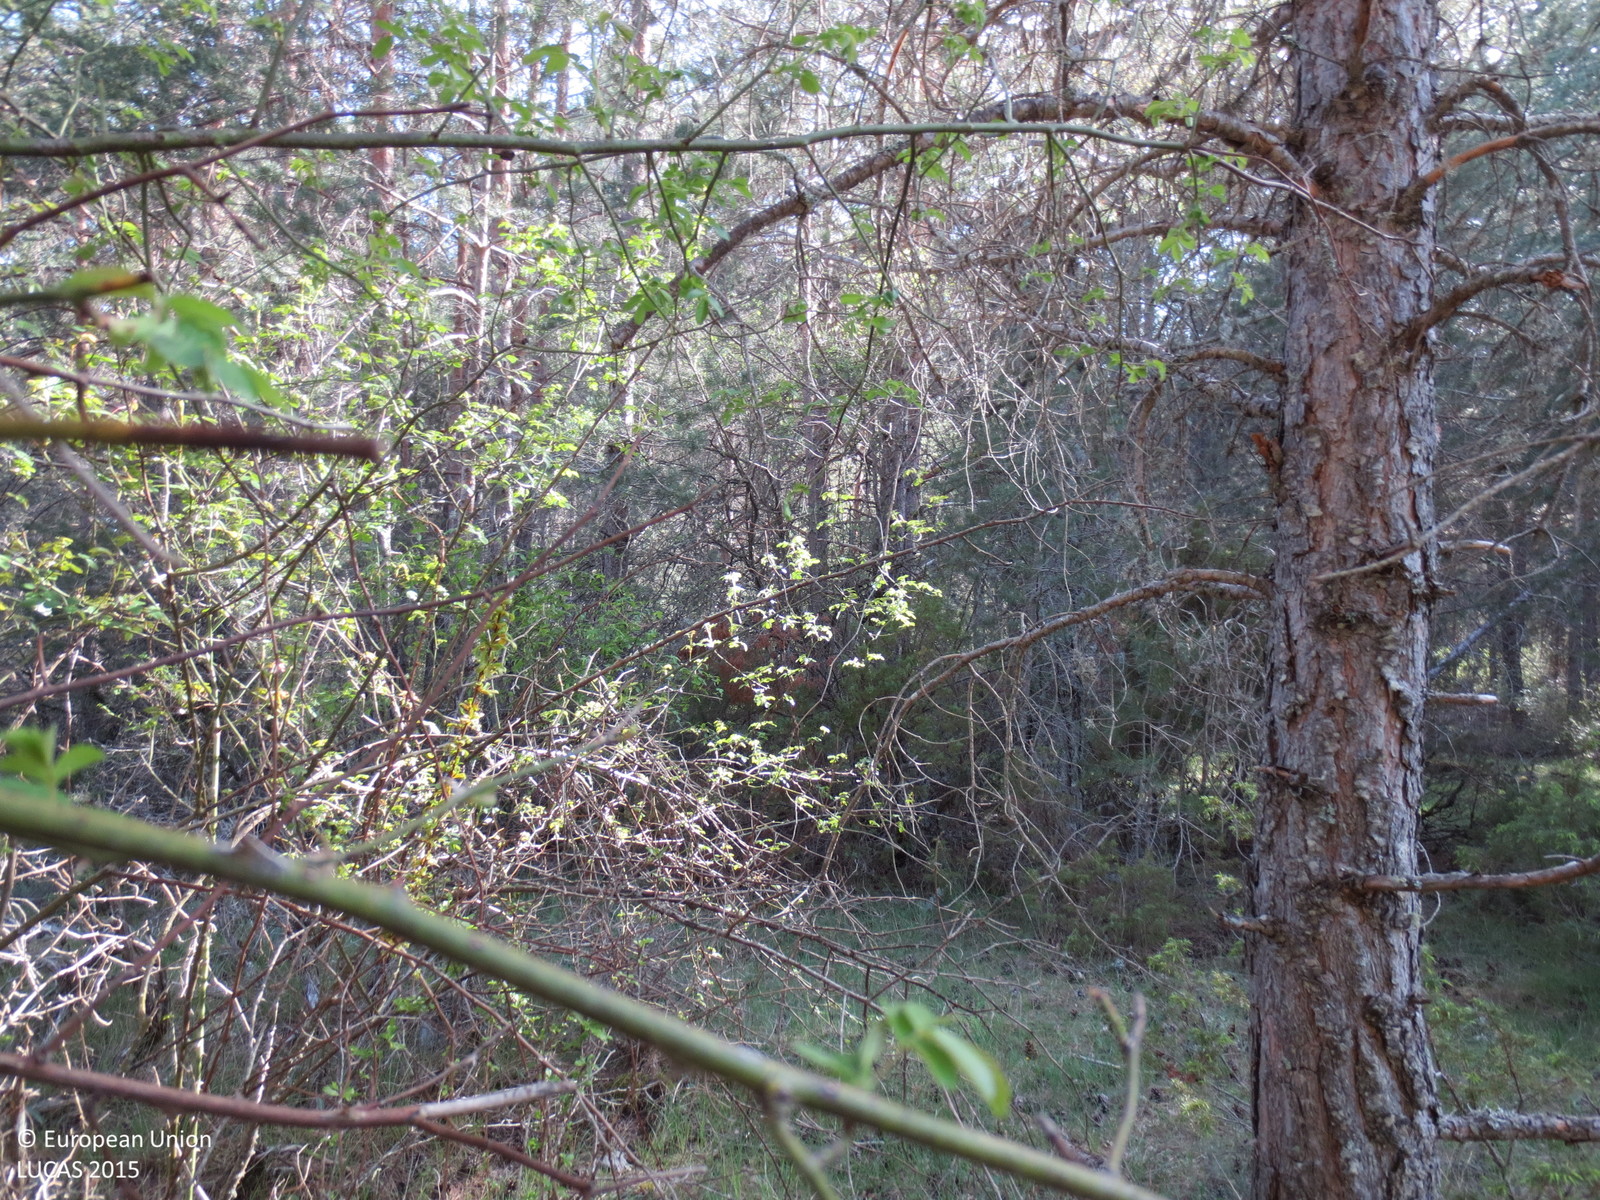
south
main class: Woodland
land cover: Pine dominated coniferous woodland
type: coniferous forest of the mediterranean region
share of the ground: 50 - 75 %
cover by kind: coniferous forest trees 60 %, shrubs 20 %, herbaceous plants 20 %
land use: Forestry
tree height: > 5 m
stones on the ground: > 50 %
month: May
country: ES
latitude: 40.4552
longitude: -2.0353
